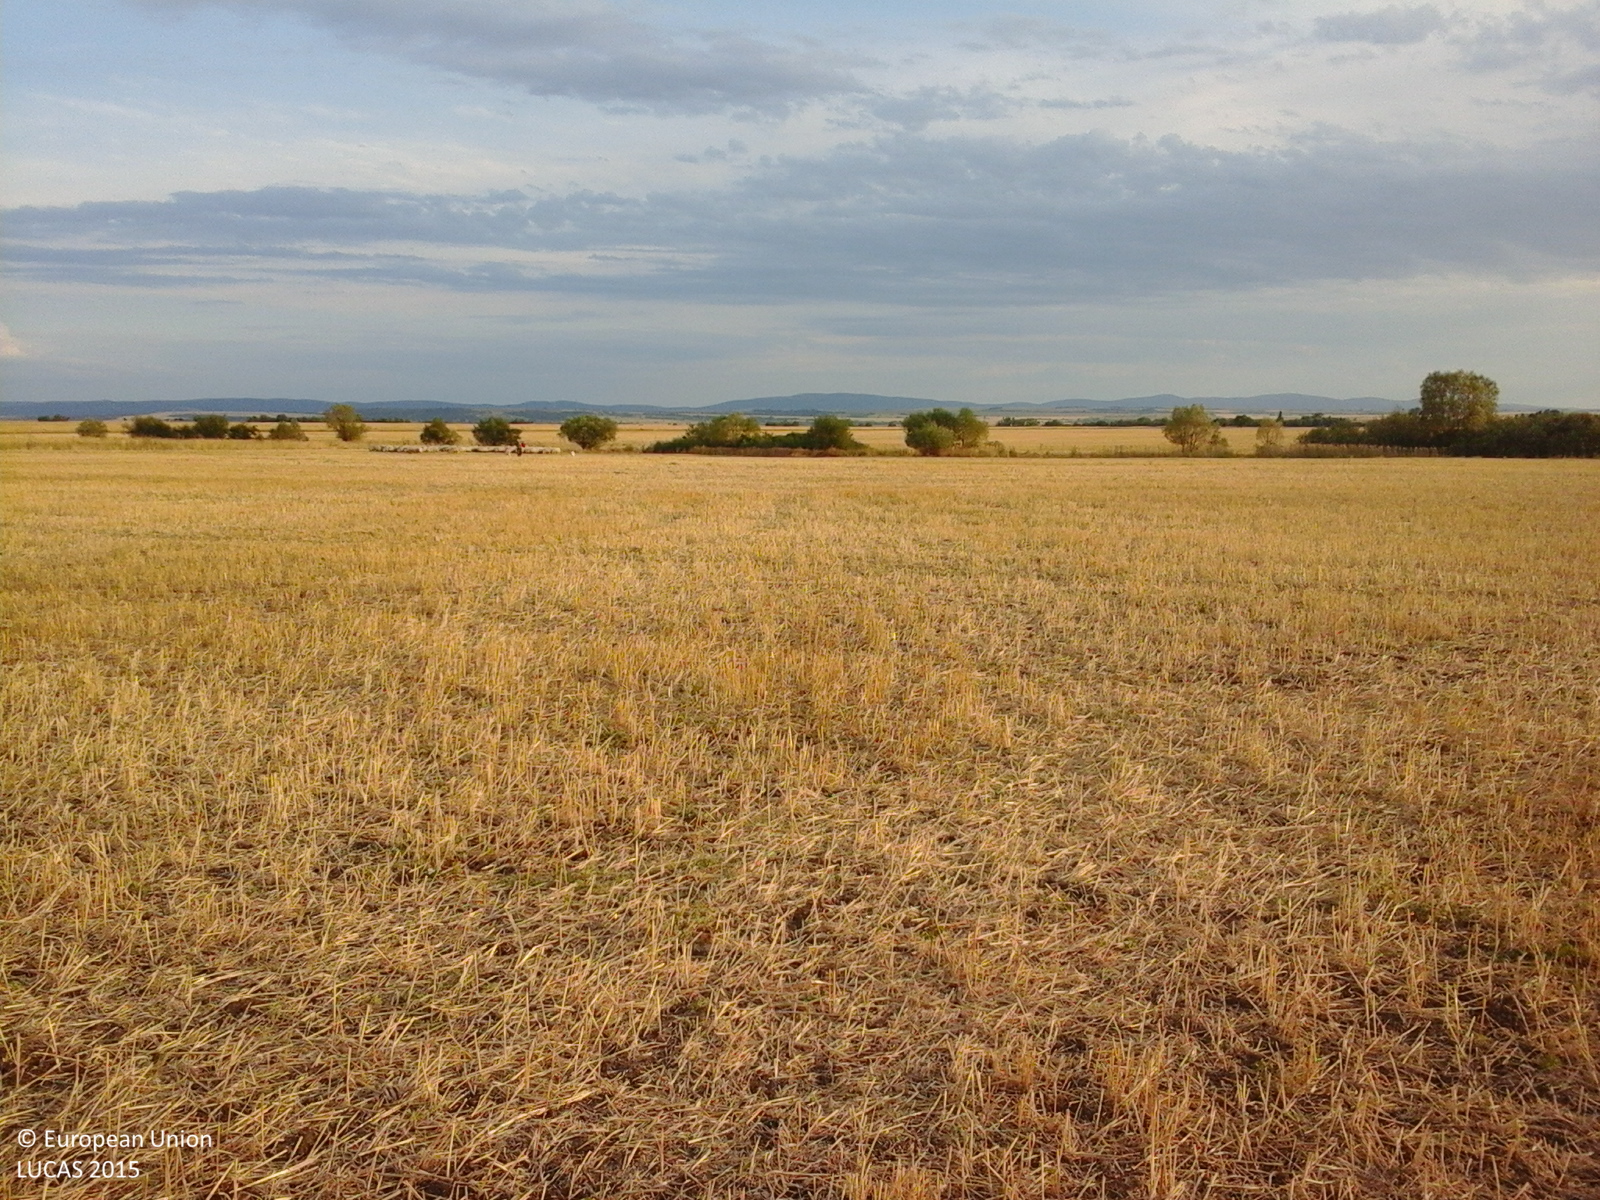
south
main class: Cropland
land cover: Durum wheat
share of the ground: > 75 %
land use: Agriculture (excluding fallow land and kitchen gardens)
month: August
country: RO
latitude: 45.0122
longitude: 21.5639
